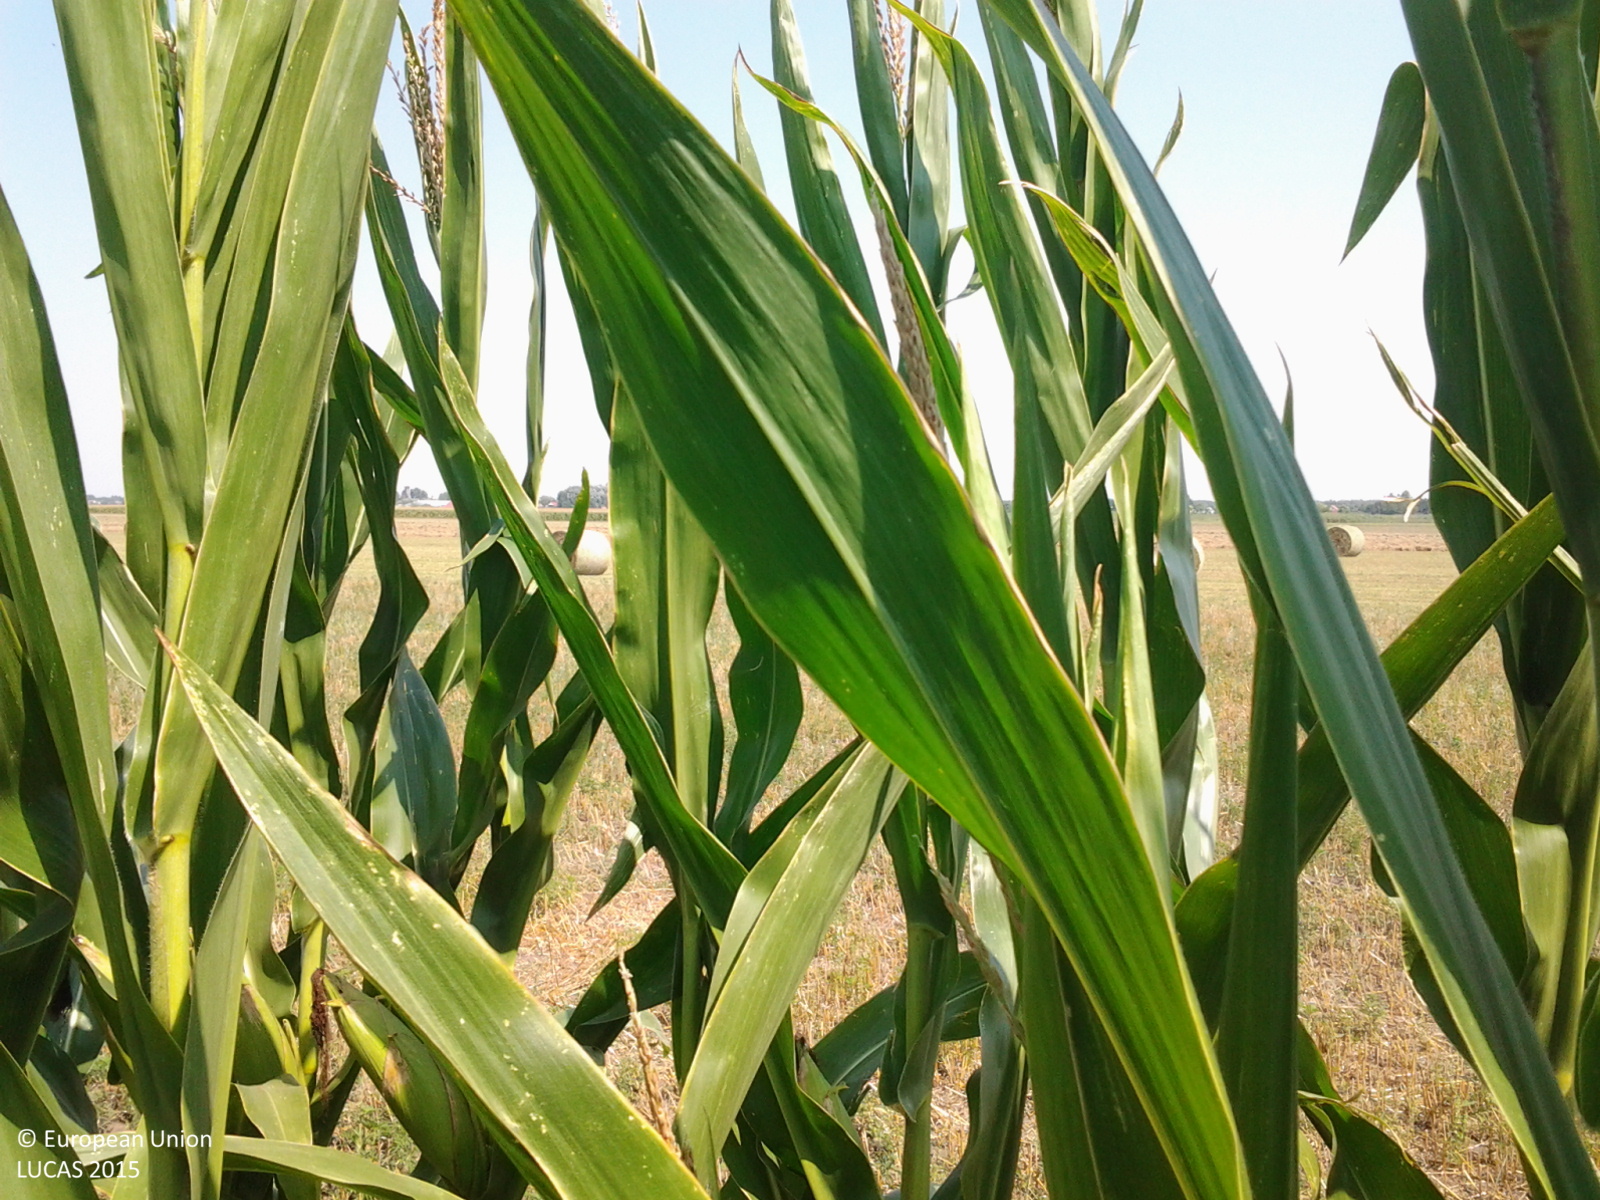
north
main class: Cropland
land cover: Maize
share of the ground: > 75 %
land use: Agriculture (excluding fallow land and kitchen gardens)
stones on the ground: < 10 %
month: August
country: HU
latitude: 47.2742
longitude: 19.8452
